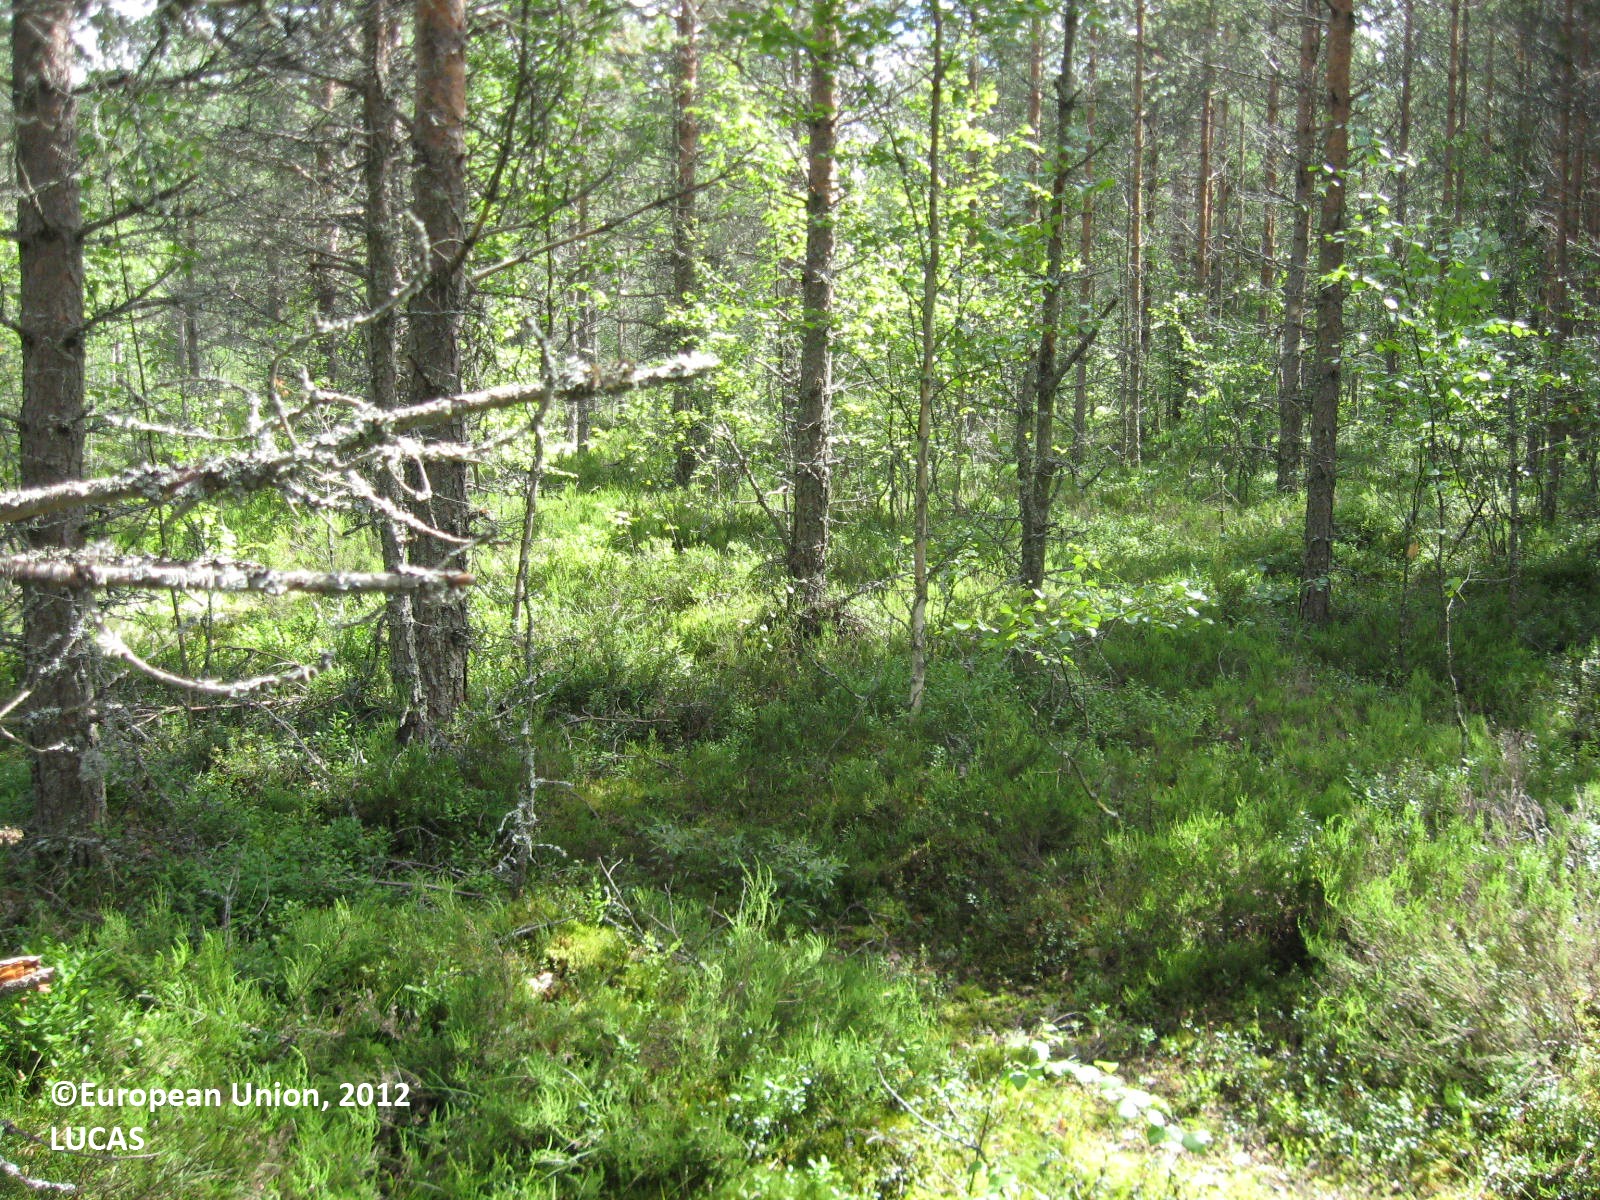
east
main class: Woodland
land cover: Pine dominated coniferous woodland
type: boreal forest
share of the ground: > 75 %
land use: Forestry
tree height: > 5 m
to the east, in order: Pine dominated coniferous woodland; Ditches and canals; Pine dominated coniferous woodland; Ditches and canals; Pine dominated mixed woodland
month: July
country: FI
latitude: 62.3037
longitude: 22.3403
